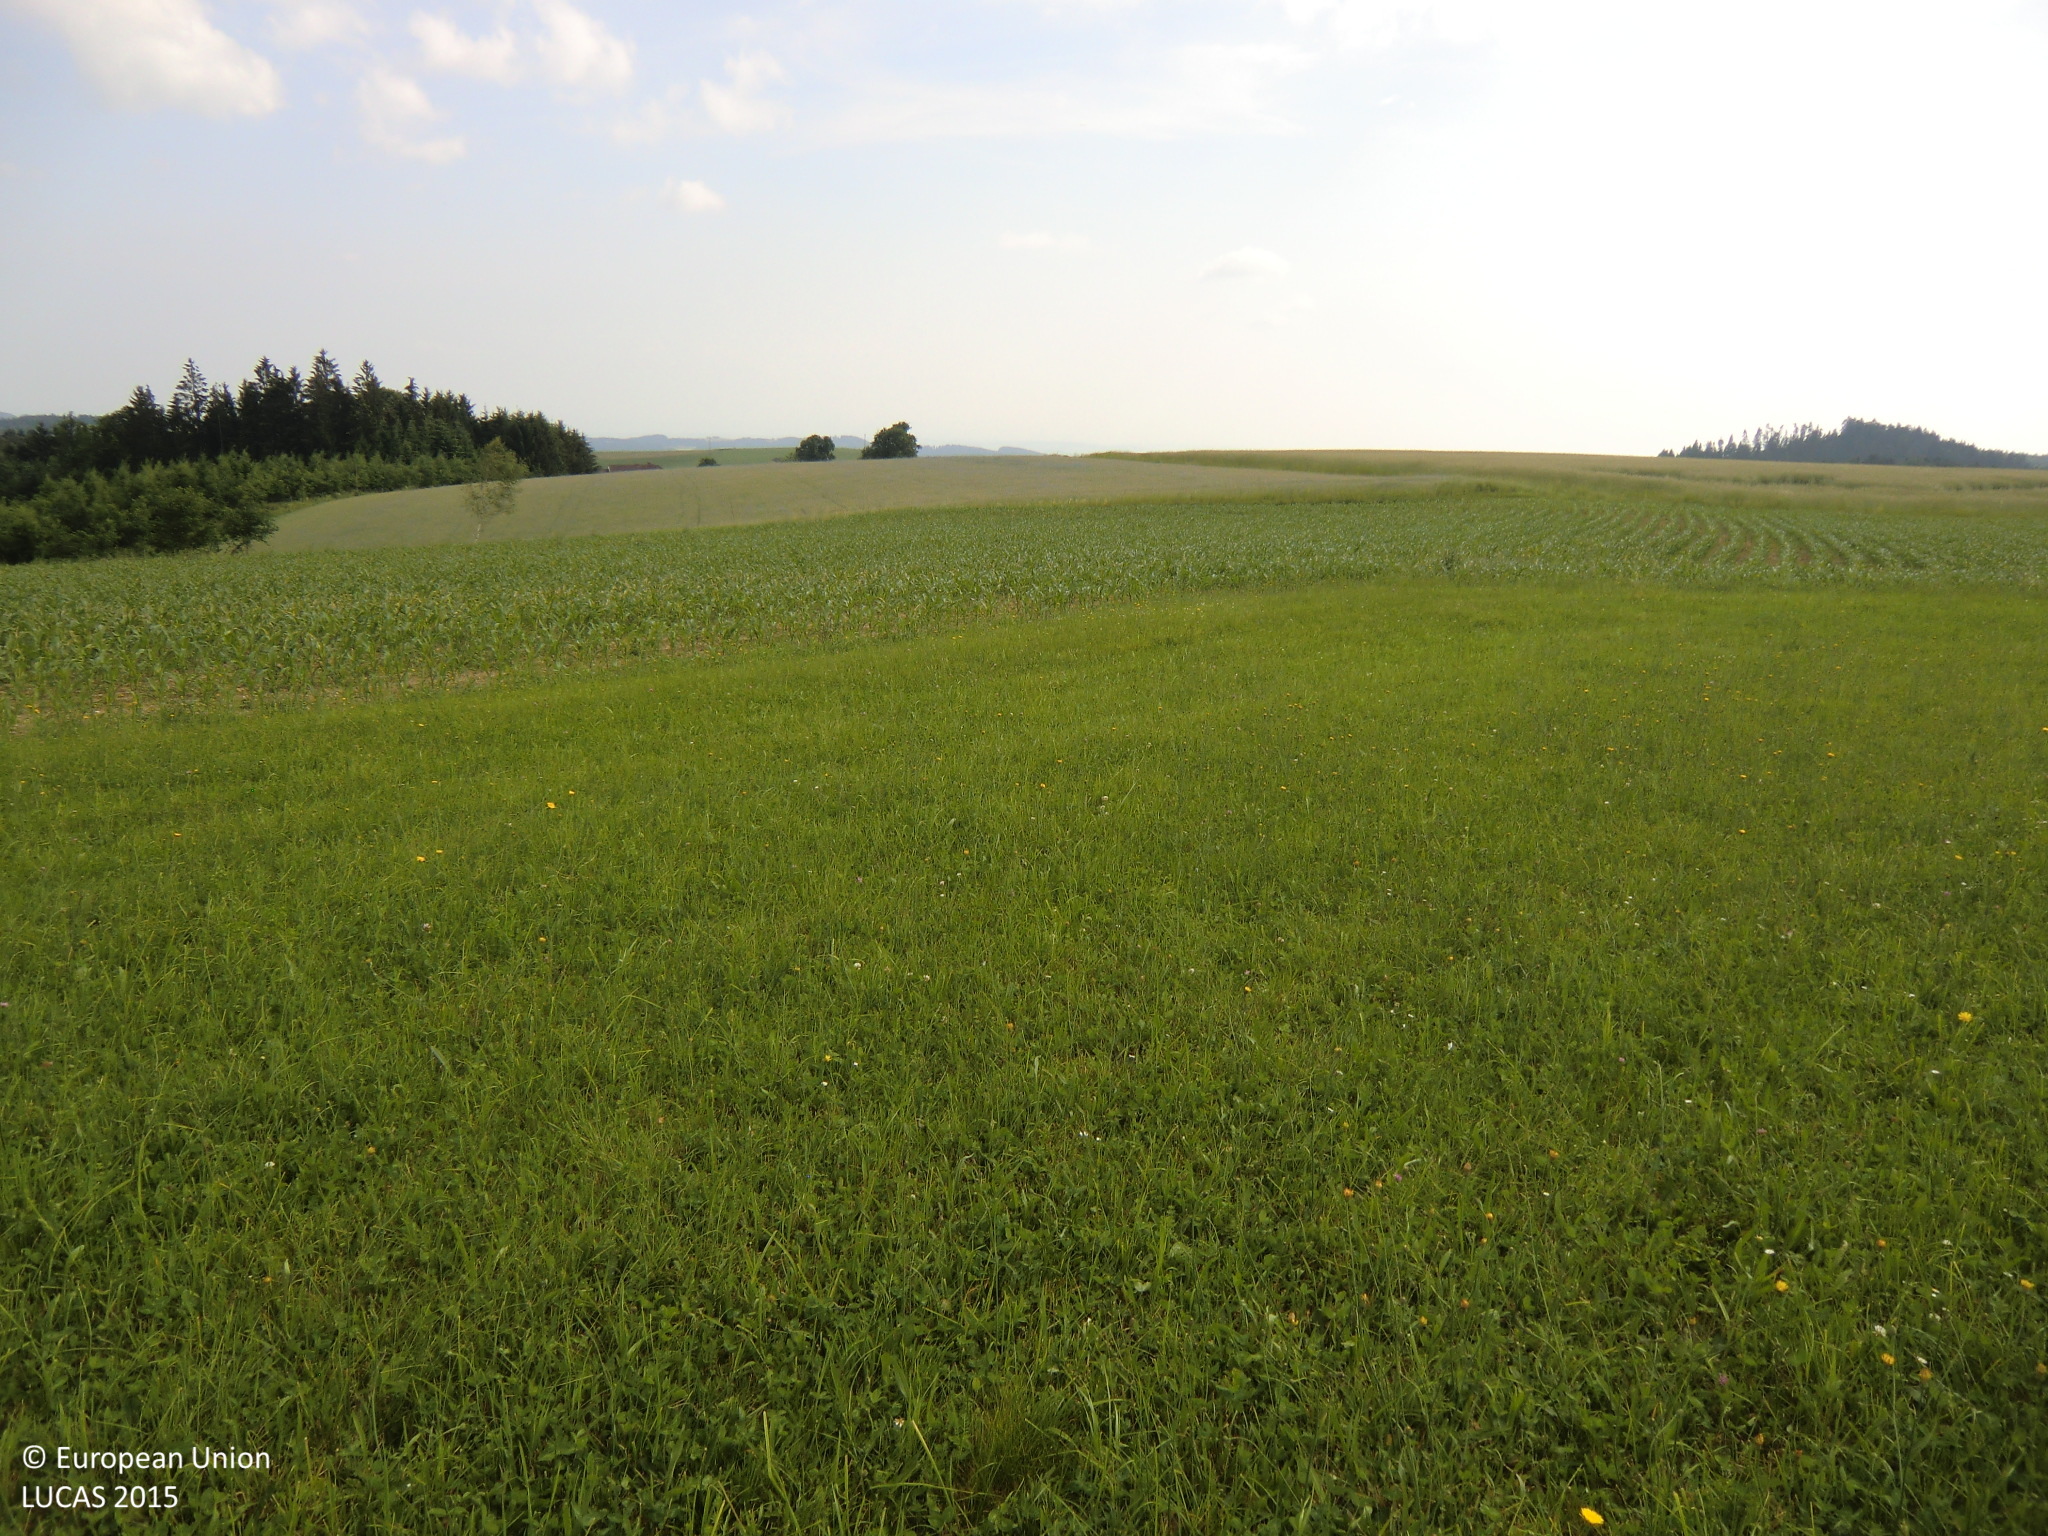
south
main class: Grassland
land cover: Grassland without tree/shrub cover
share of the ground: > 75 %
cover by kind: herbaceous plants 100 %
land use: Agriculture (excluding fallow land and kitchen gardens)
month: June
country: AT
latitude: 48.3606
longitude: 14.6301
